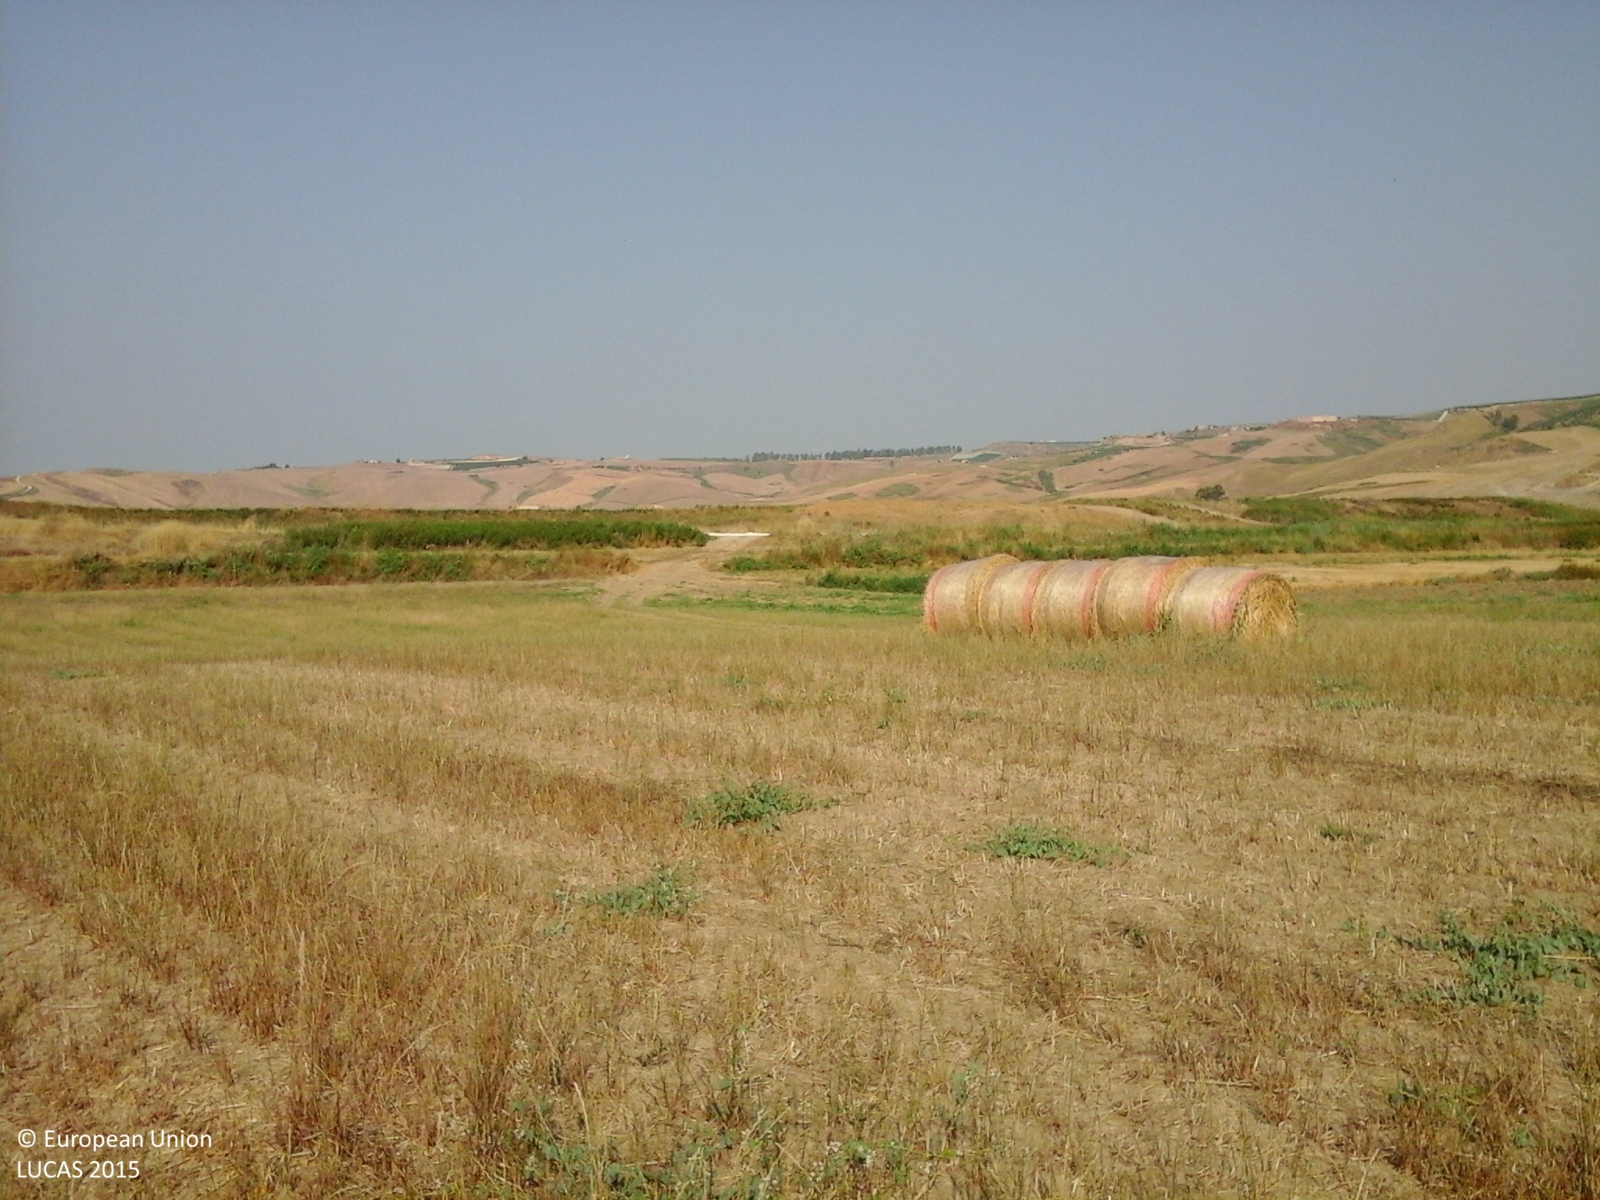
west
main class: Cropland
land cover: Durum wheat
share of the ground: > 75 %
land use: Agriculture (excluding fallow land and kitchen gardens)
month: July
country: IT
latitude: 37.1912
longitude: 13.9904
